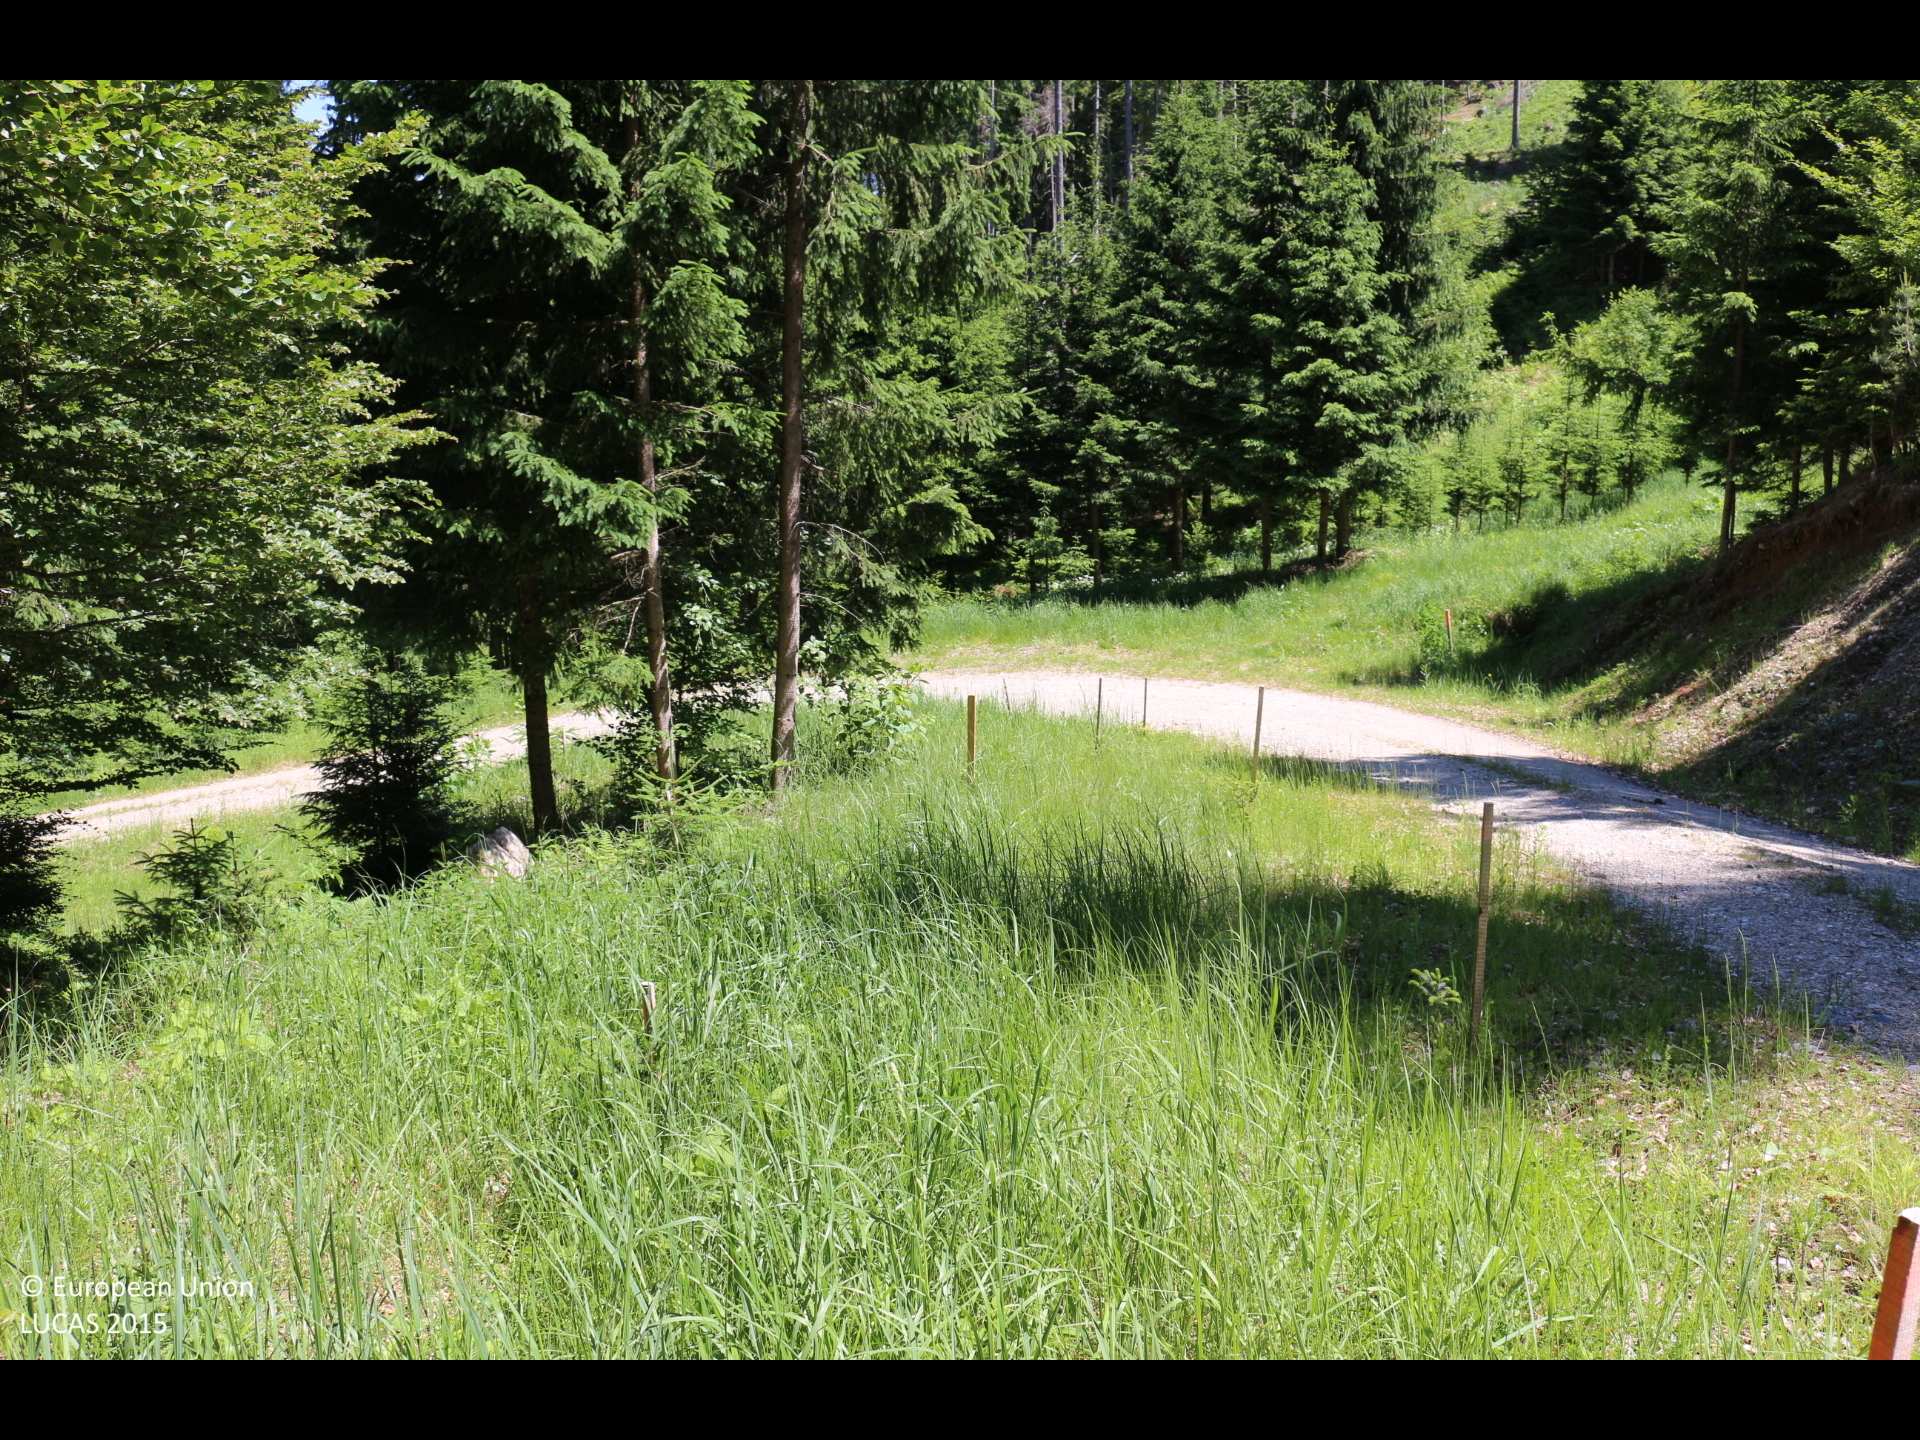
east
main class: Woodland
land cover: Spruce dominated mixed woodland
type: mountainous beech forest
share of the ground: > 75 %
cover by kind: coniferous forest trees 60 %, broadleaved forest trees 35 %, herbaceous plants 5 %
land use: Forestry
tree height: > 5 m
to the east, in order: Spruce dominated mixed woodland; Grass margins; Tracks; Grass margins; Spruce dominated mixed woodland; Tracks; Spruce dominated coniferous woodland; Spruce dominated mixed woodland; Tracks; Broadleaved woodland; Ditches and canals; Broadleaved woodland; Shrubland without tree cover; Shrubland with sparse tree cover
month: May
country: AT
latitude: 46.5279
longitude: 14.0255
